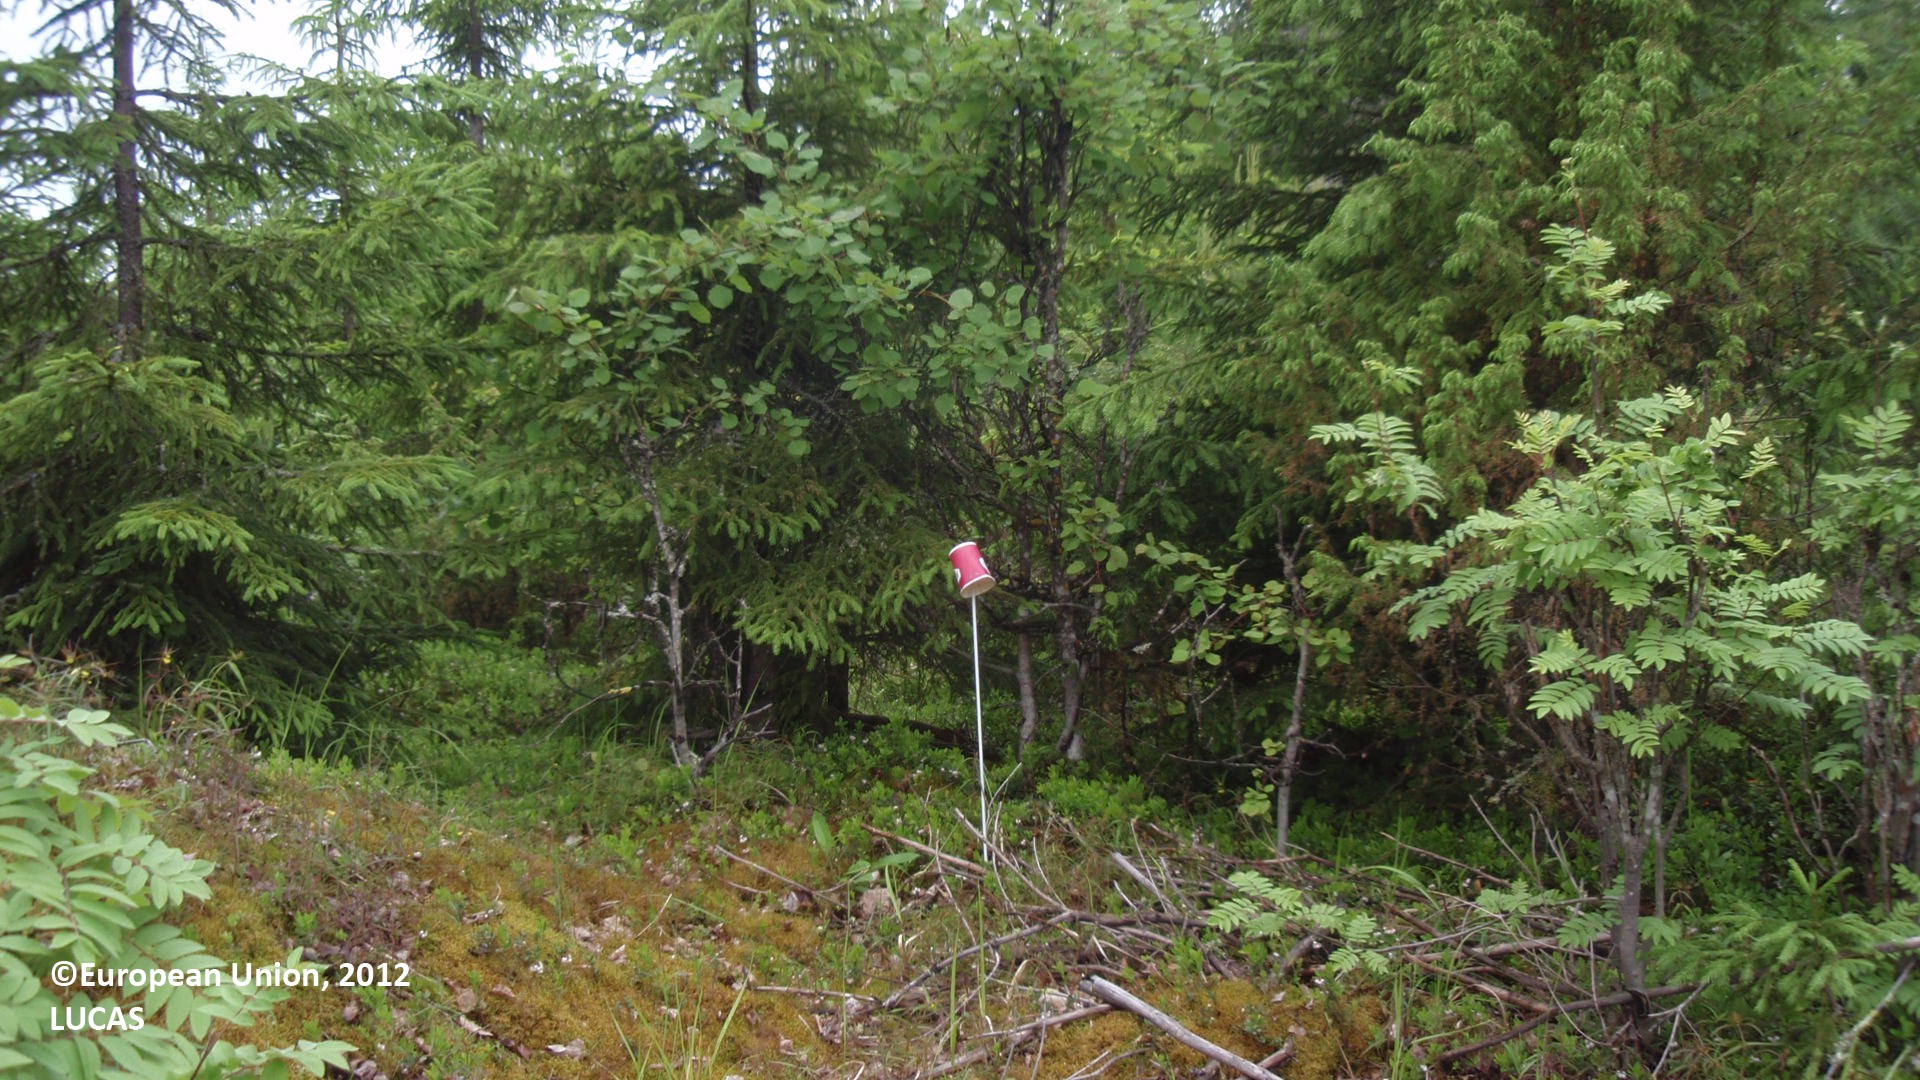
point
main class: Woodland
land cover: Spruce dominated coniferous woodland
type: boreal forest
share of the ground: > 75 %
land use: Forestry
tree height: < 5 m
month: June
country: FI
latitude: 61.3107
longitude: 26.7572
